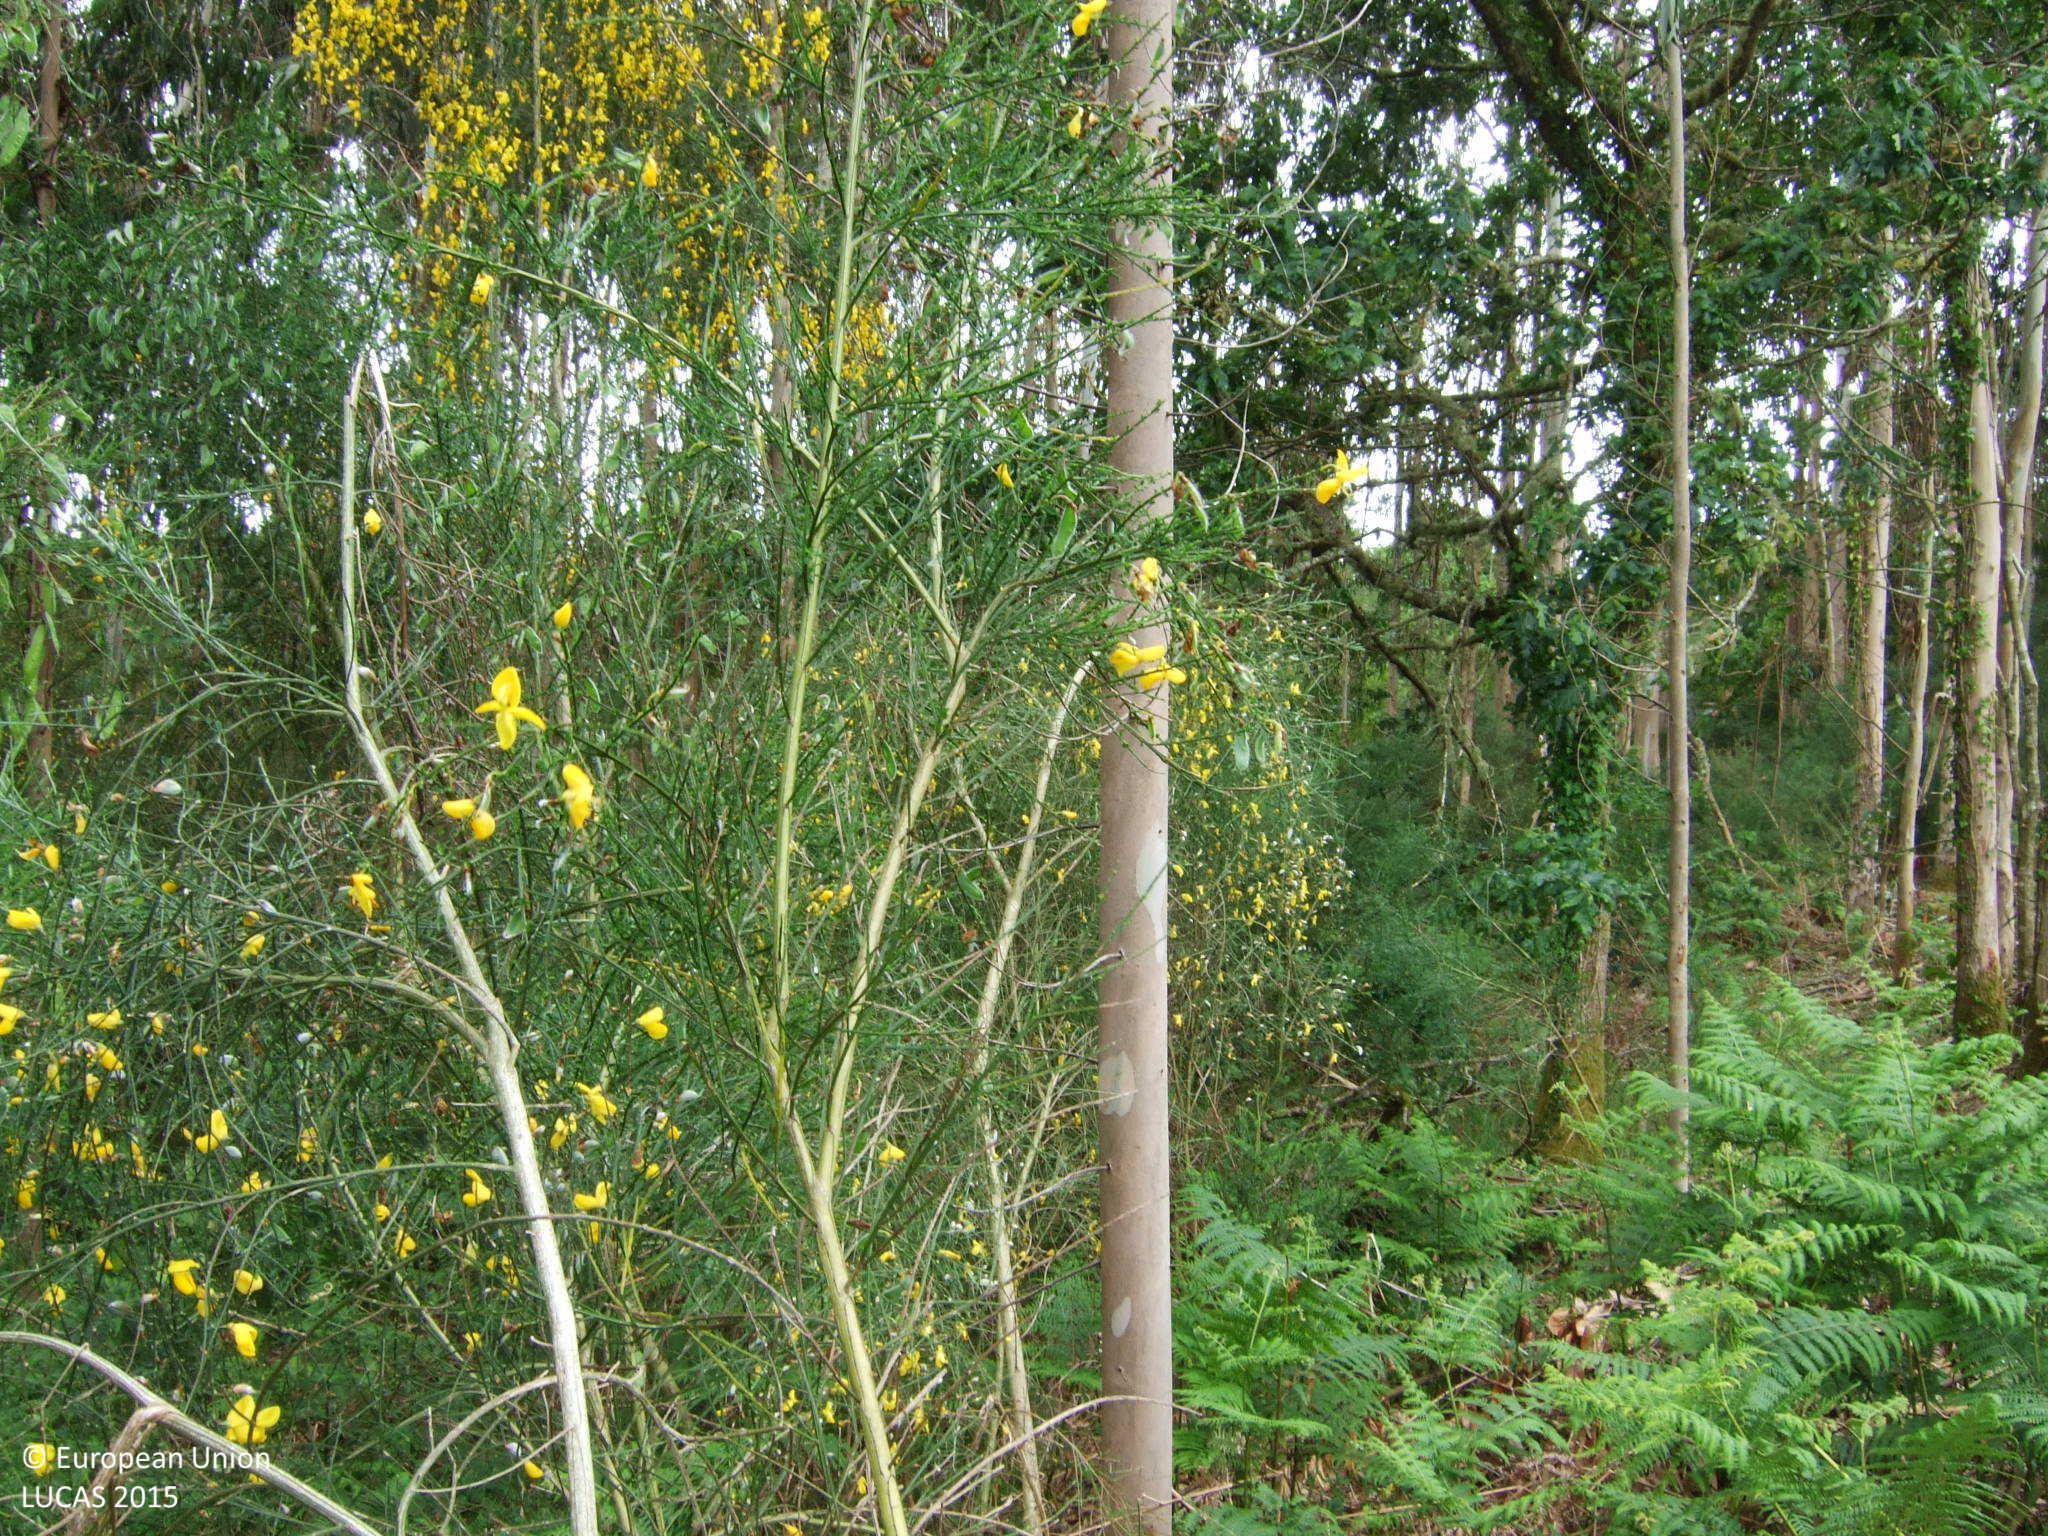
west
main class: Woodland
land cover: Broadleaved woodland
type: exotic forest
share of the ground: 25 - 50 %
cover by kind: shrubs 60 %, broadleaved forest trees 40 %
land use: Forestry
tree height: > 5 m
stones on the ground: < 10 %
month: June
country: ES
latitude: 43.5775
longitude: -7.7610
